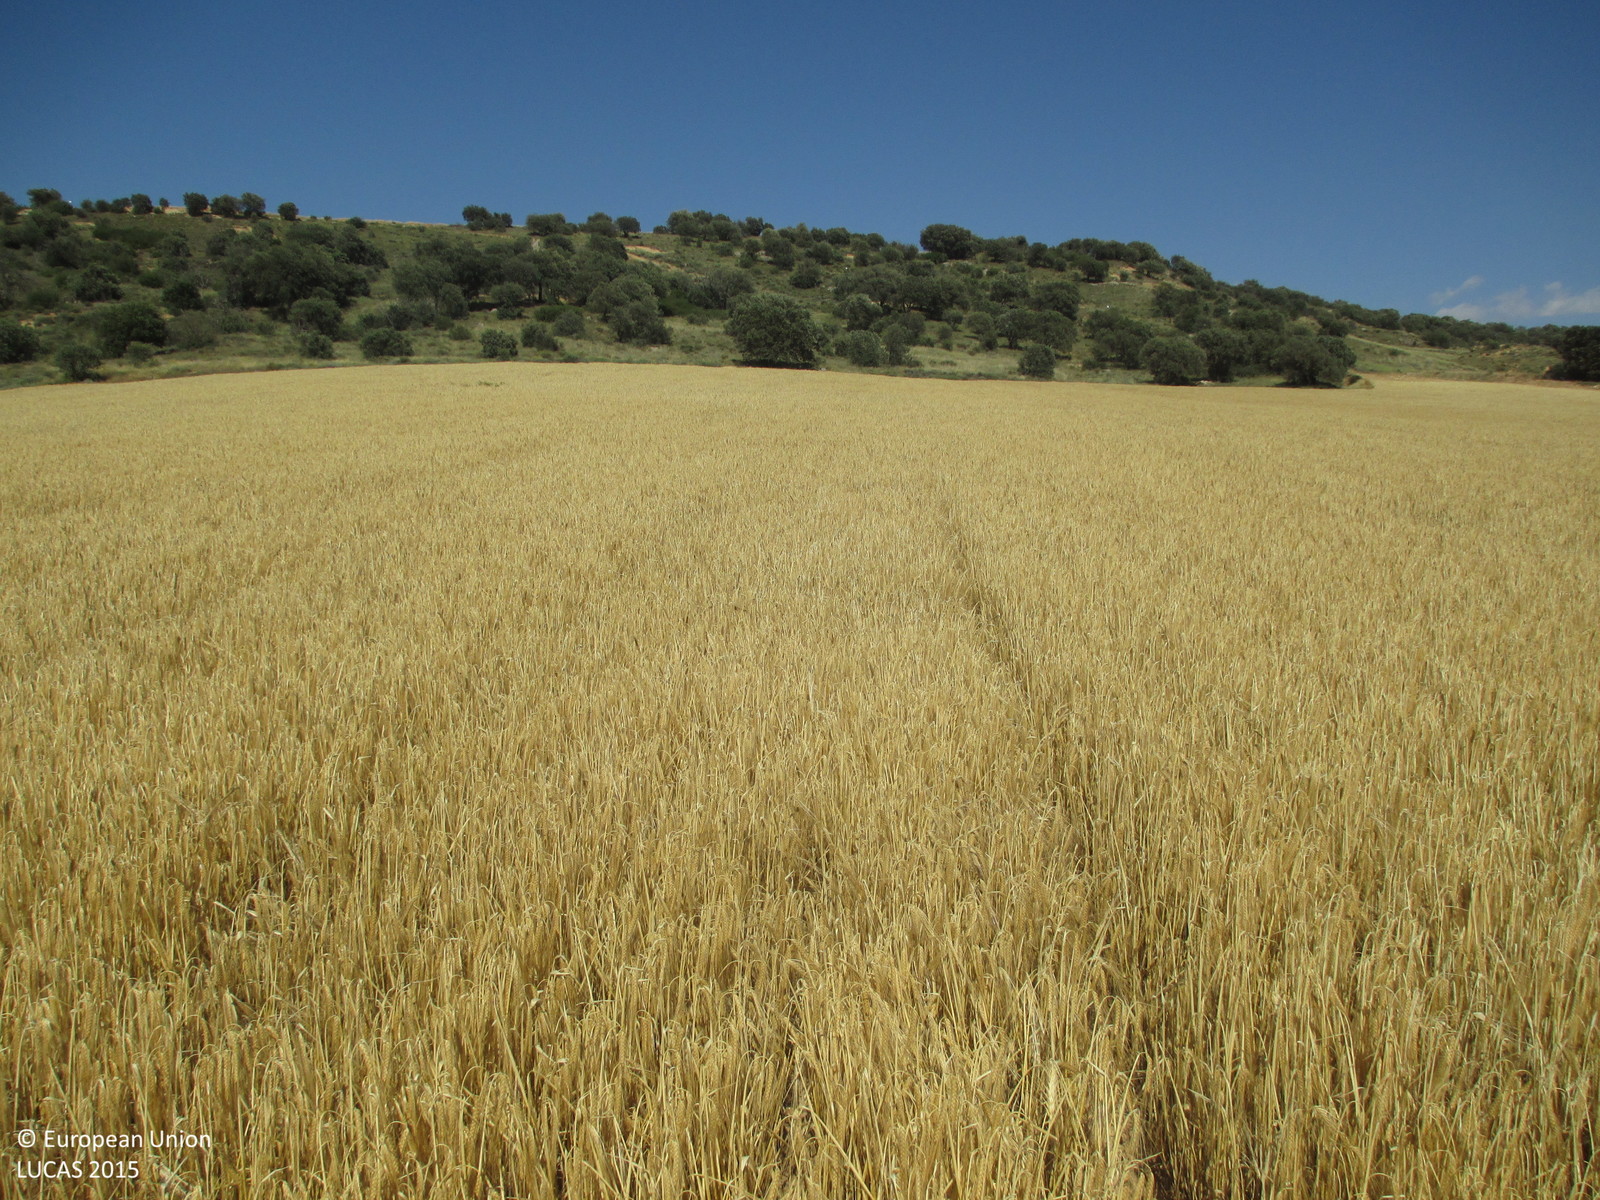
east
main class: Cropland
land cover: Barley
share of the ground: > 75 %
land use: Agriculture (excluding fallow land and kitchen gardens)
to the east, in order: Barley; Broadleaved woodland; Tracks; Grassland with sparse tree/shrub cover; Shrubland without tree cover
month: June
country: ES
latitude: 42.0698
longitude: -0.3308
